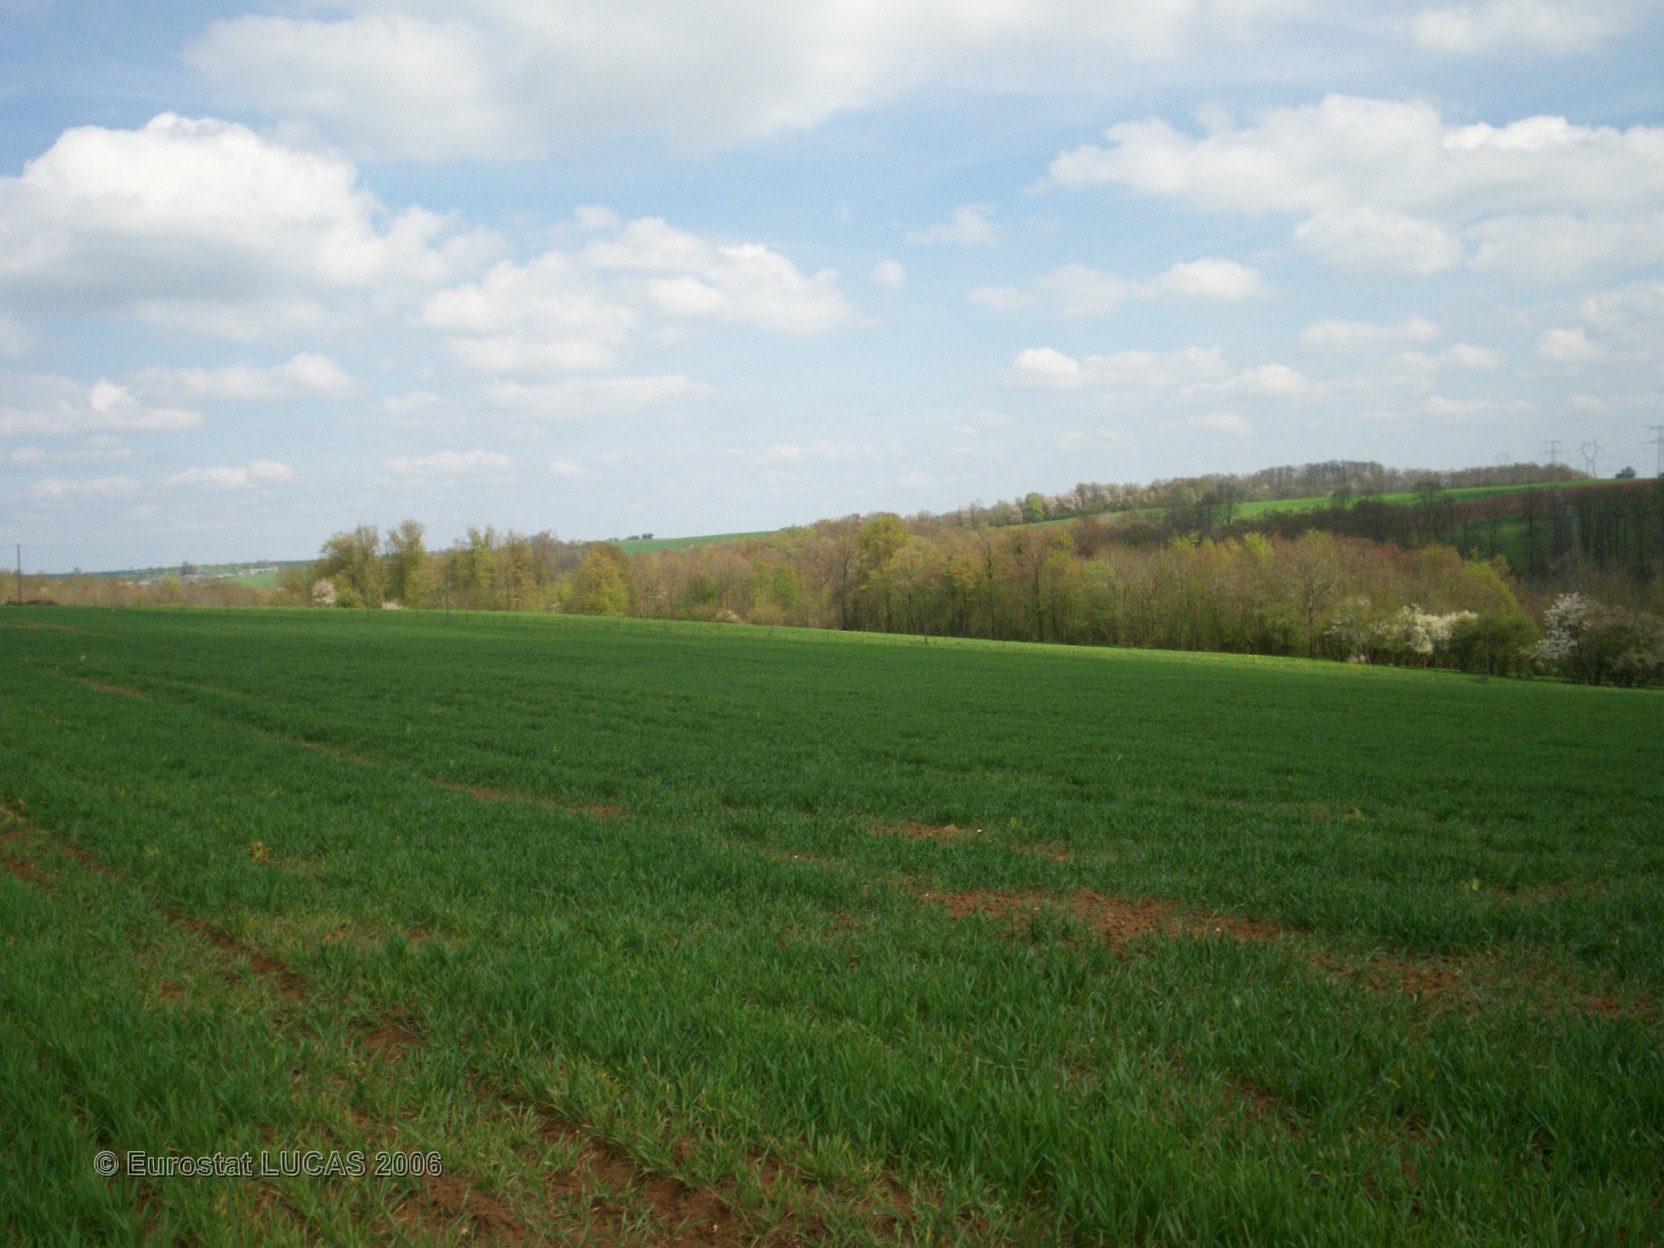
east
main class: Cropland
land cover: Common wheat
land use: Agriculture (excluding fallow land and kitchen gardens)
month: May
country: FR
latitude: 49.8107
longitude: 4.3676
